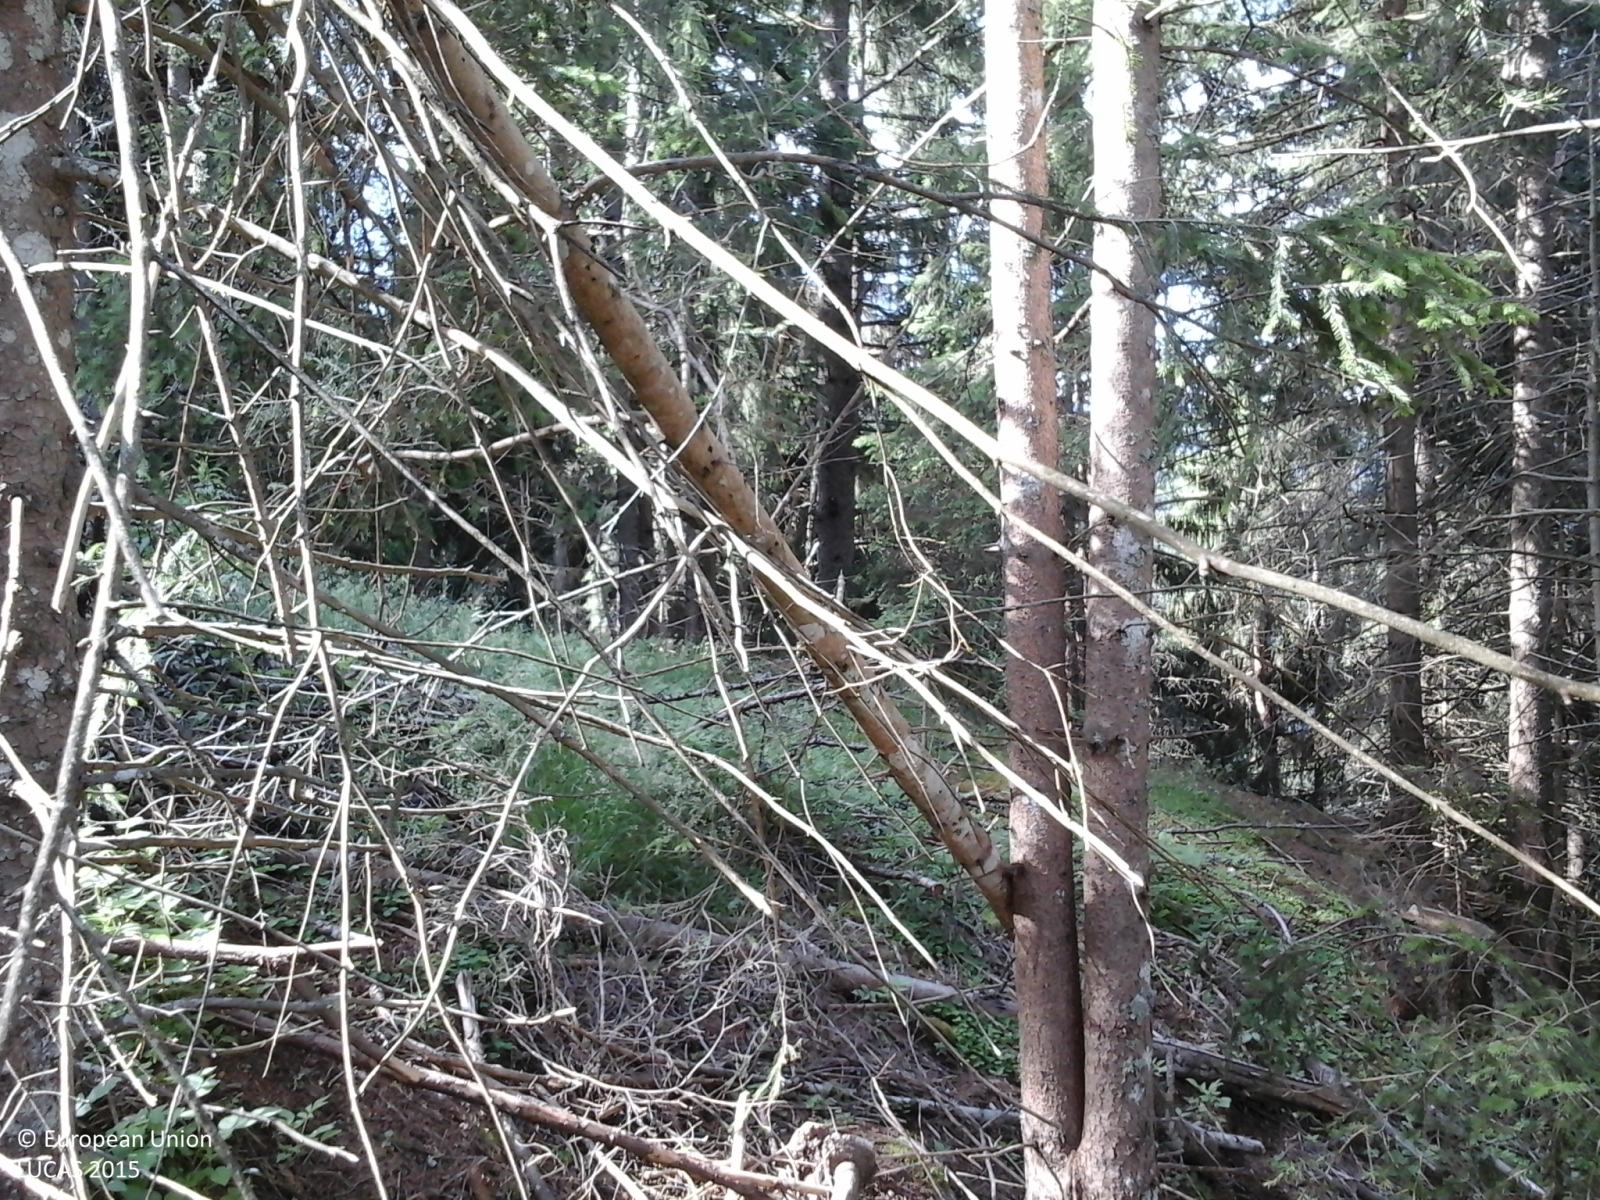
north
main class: Woodland
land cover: Spruce dominated coniferous woodland
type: alpine coniferous forest
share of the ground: > 75 %
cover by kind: coniferous forest trees 100 %
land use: Forestry
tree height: > 5 m
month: June
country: IT
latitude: 46.8374
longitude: 11.9778
